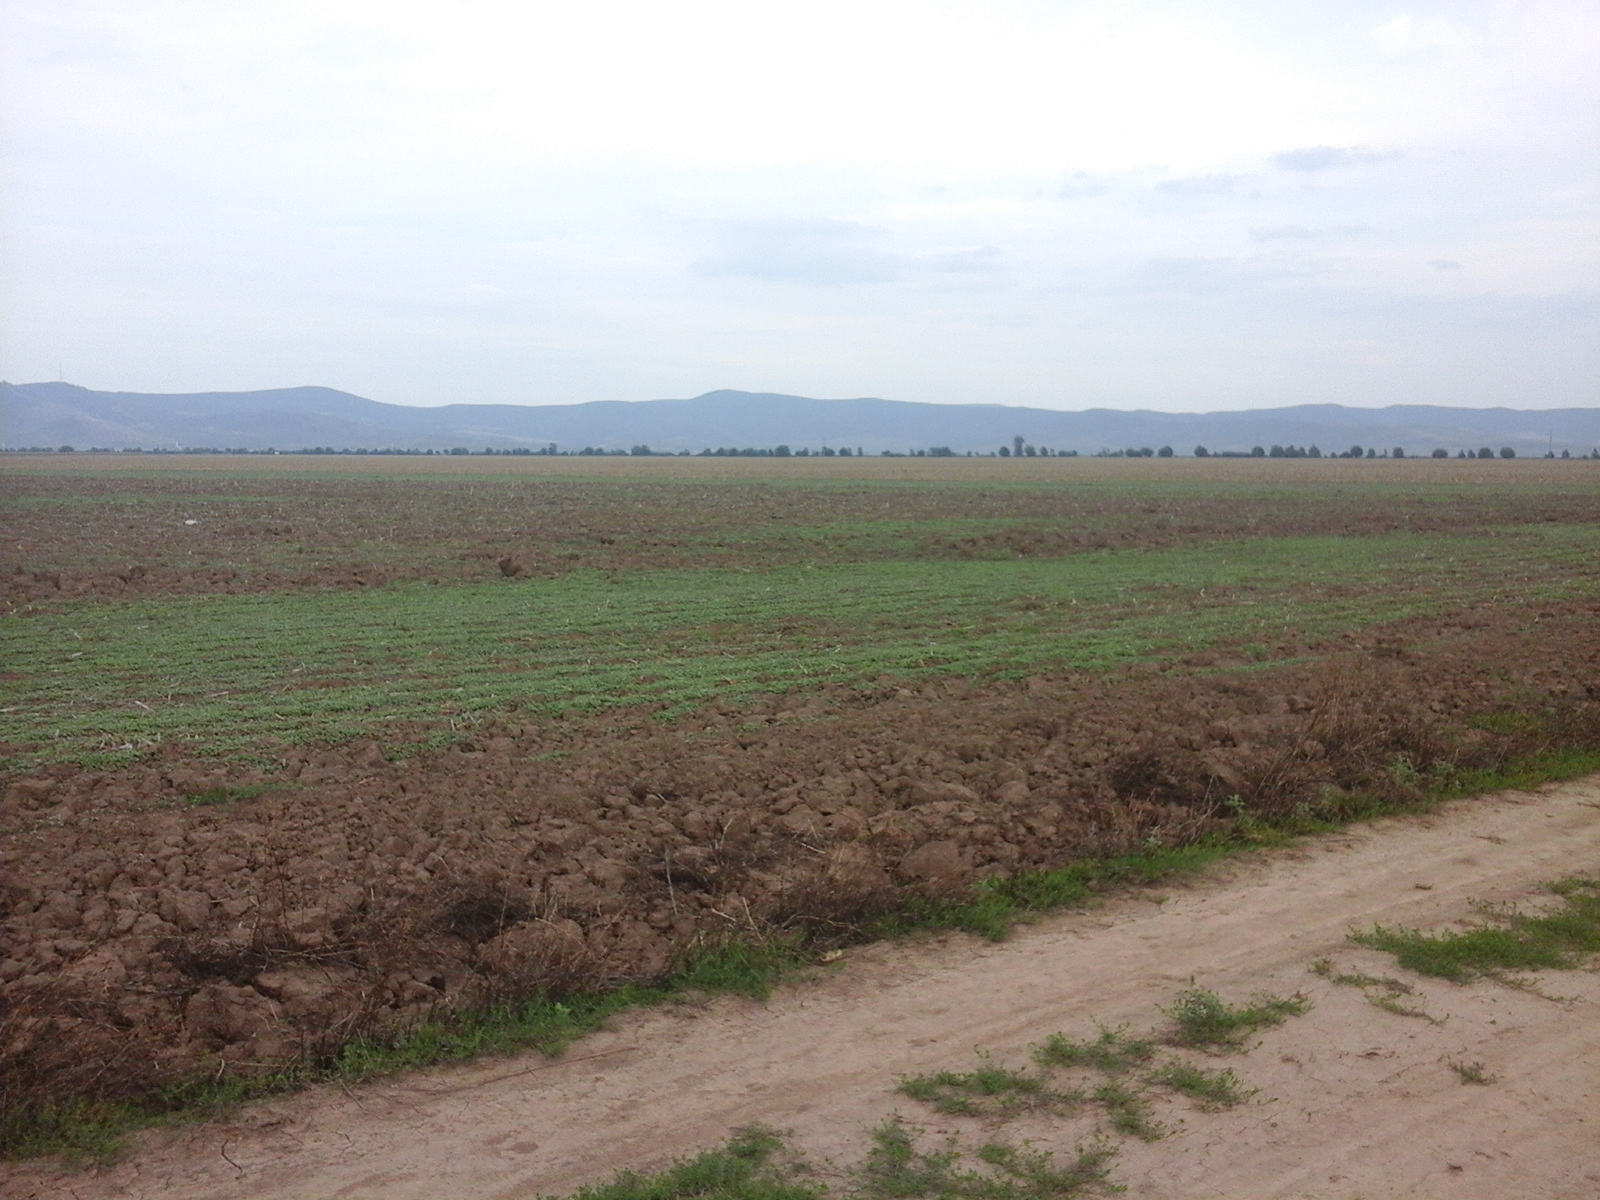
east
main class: Cropland
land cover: Maize
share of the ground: > 75 %
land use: Agriculture (excluding fallow land and kitchen gardens)
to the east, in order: Maize
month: August
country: RO
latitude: 46.2515
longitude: 21.5426
